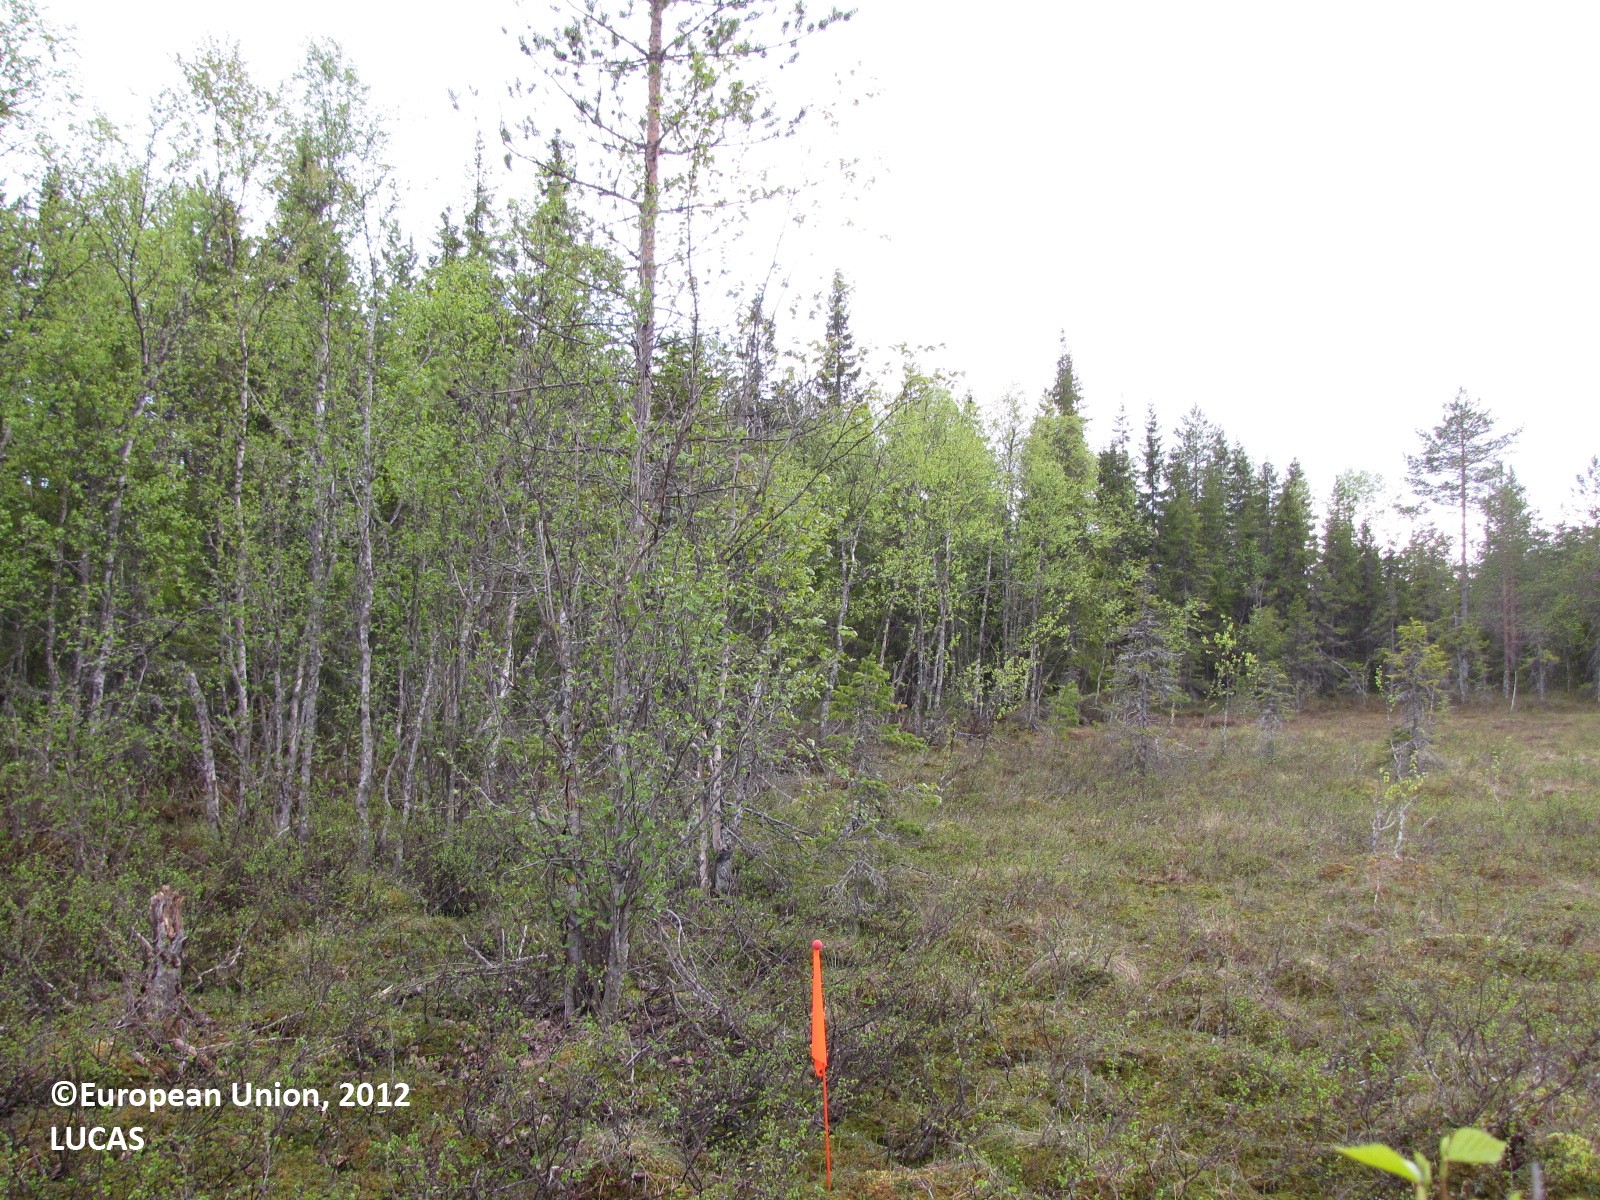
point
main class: Woodland
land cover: Spruce dominated mixed woodland
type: boreal forest
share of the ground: 25 - 50 %
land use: Forestry
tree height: > 5 m
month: June
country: FI
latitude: 65.9153
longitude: 24.7931
